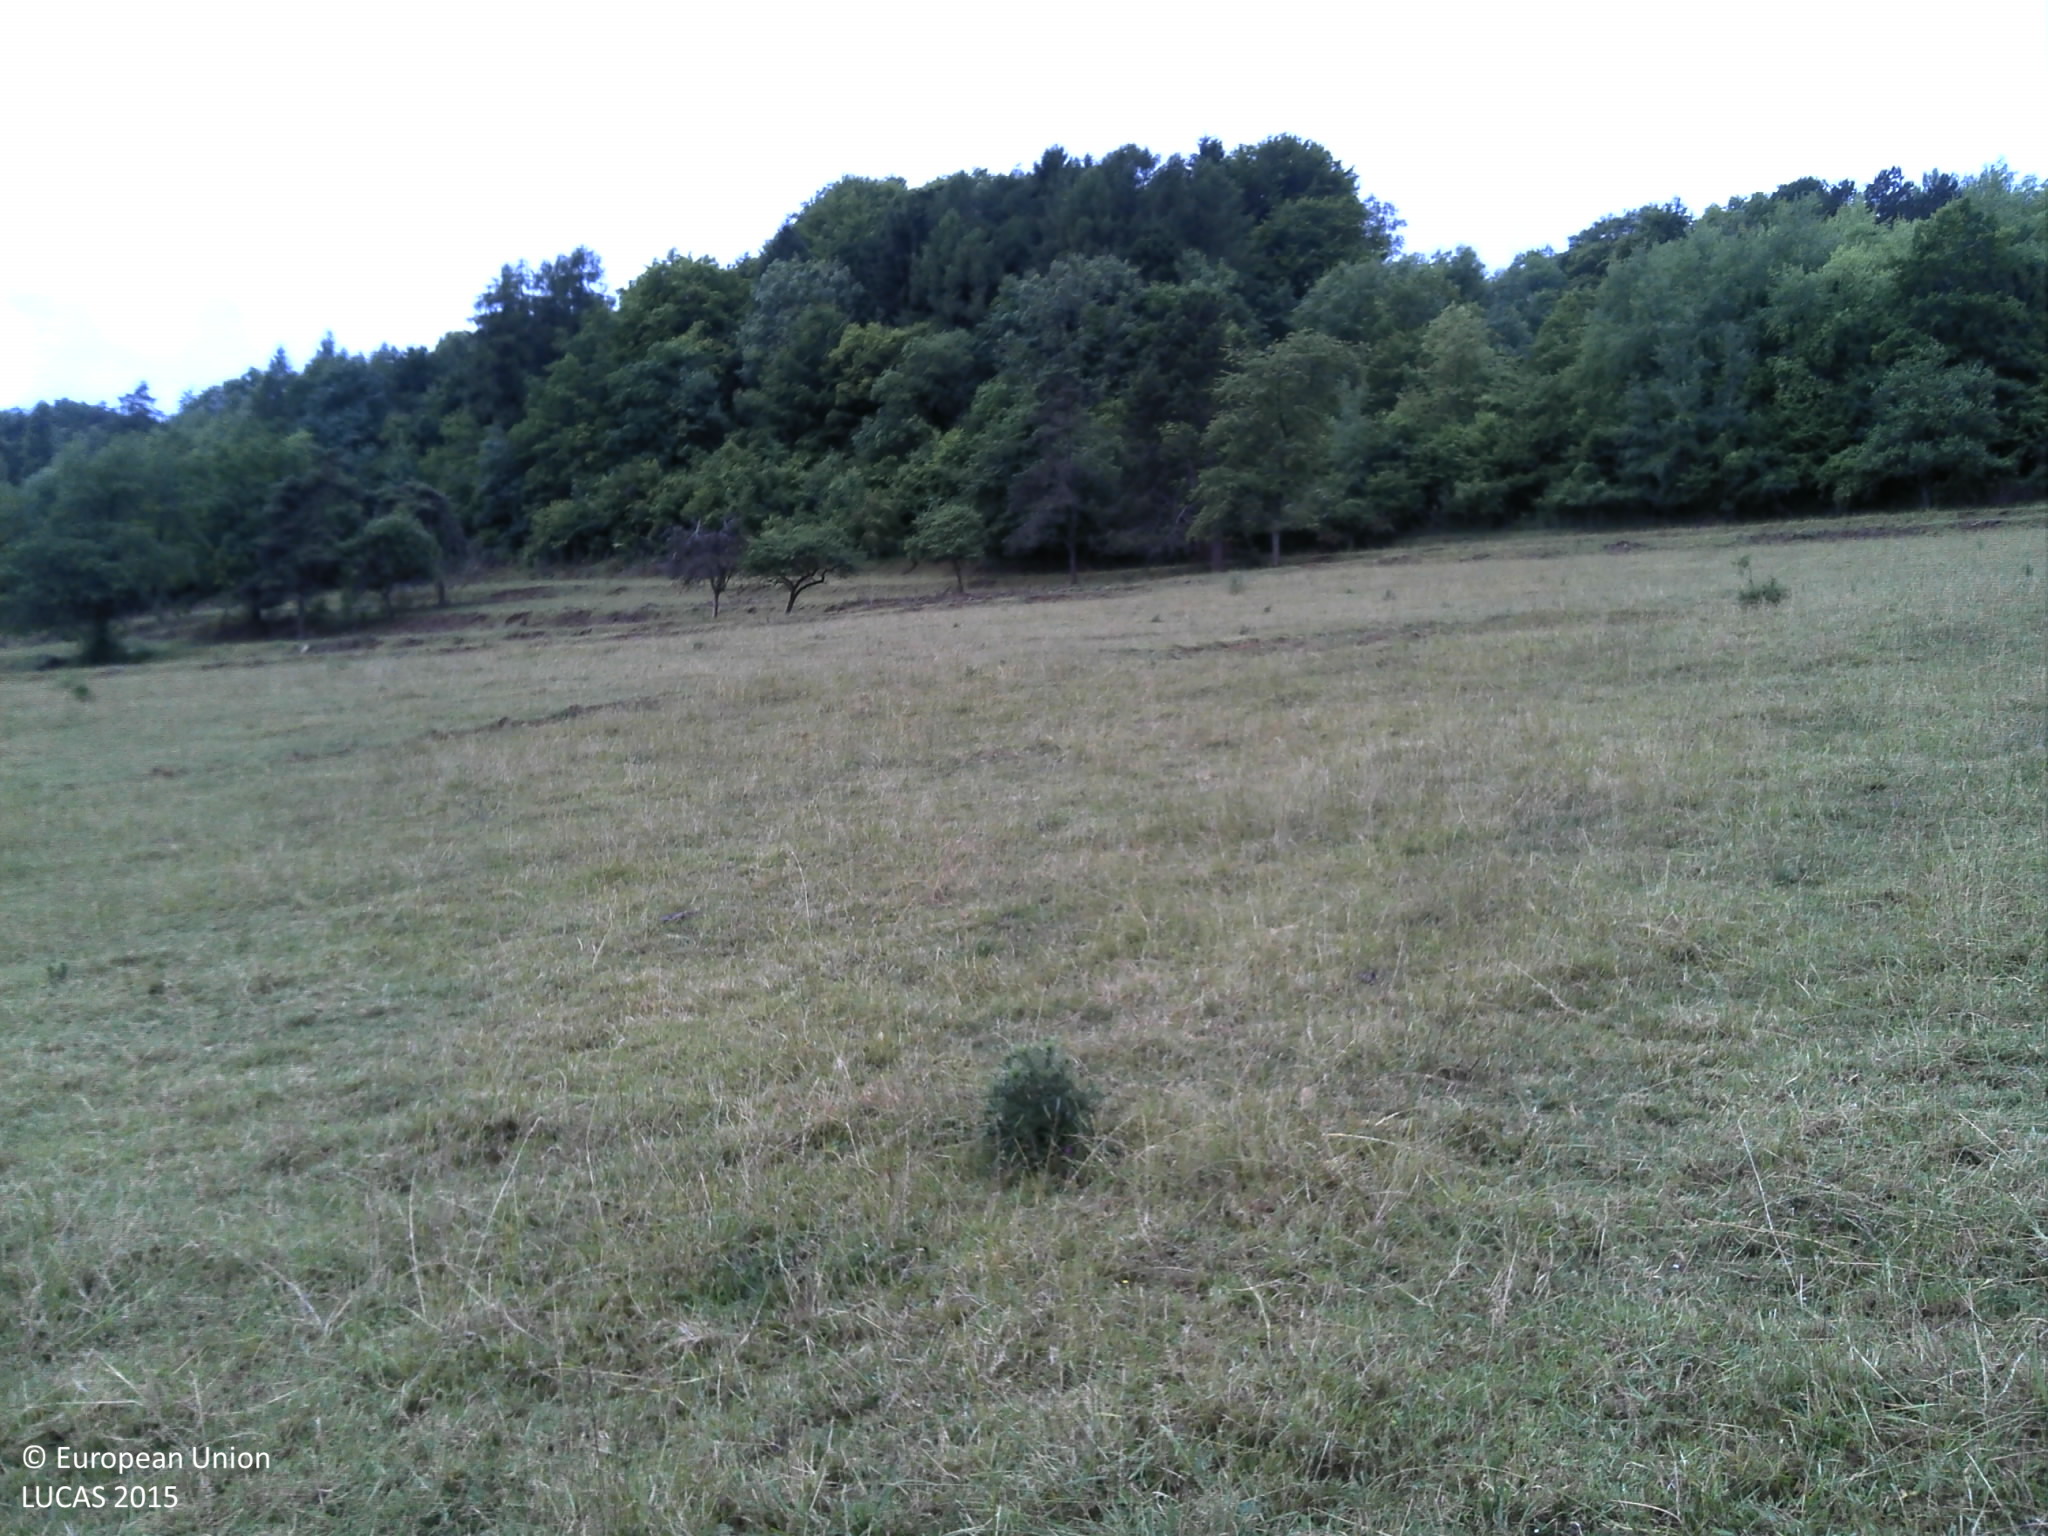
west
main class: Grassland
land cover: Grassland without tree/shrub cover
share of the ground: > 75 %
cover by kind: herbaceous plants 100 %
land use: Agriculture (excluding fallow land and kitchen gardens)
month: June
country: FR
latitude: 49.6705
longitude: 4.8286
